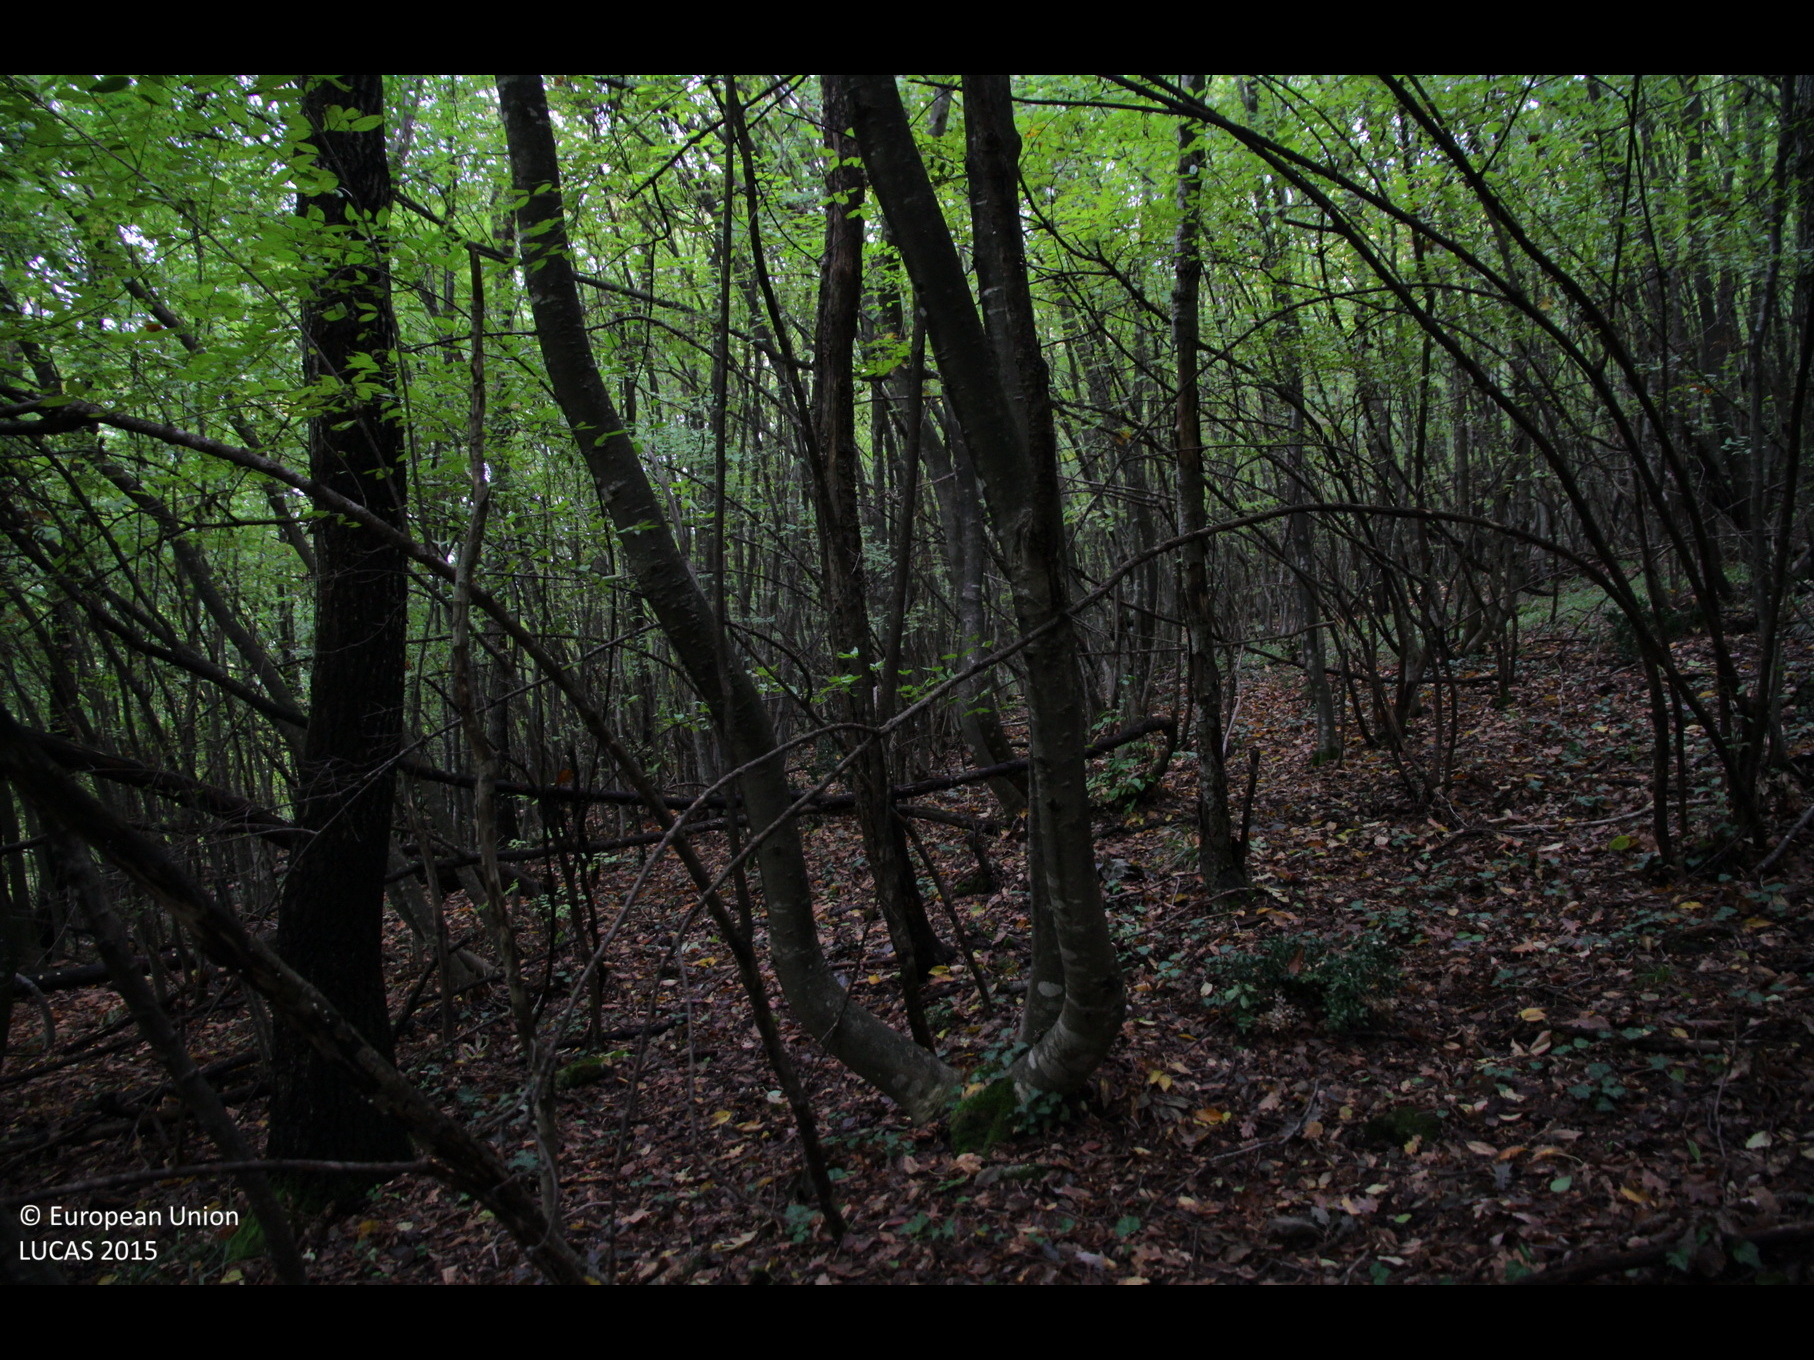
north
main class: Woodland
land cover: Broadleaved woodland
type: beech forest
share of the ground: > 75 %
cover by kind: broadleaved forest trees 100 %
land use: Forestry
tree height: > 5 m
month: October
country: BG
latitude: 43.4718
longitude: 27.0922
